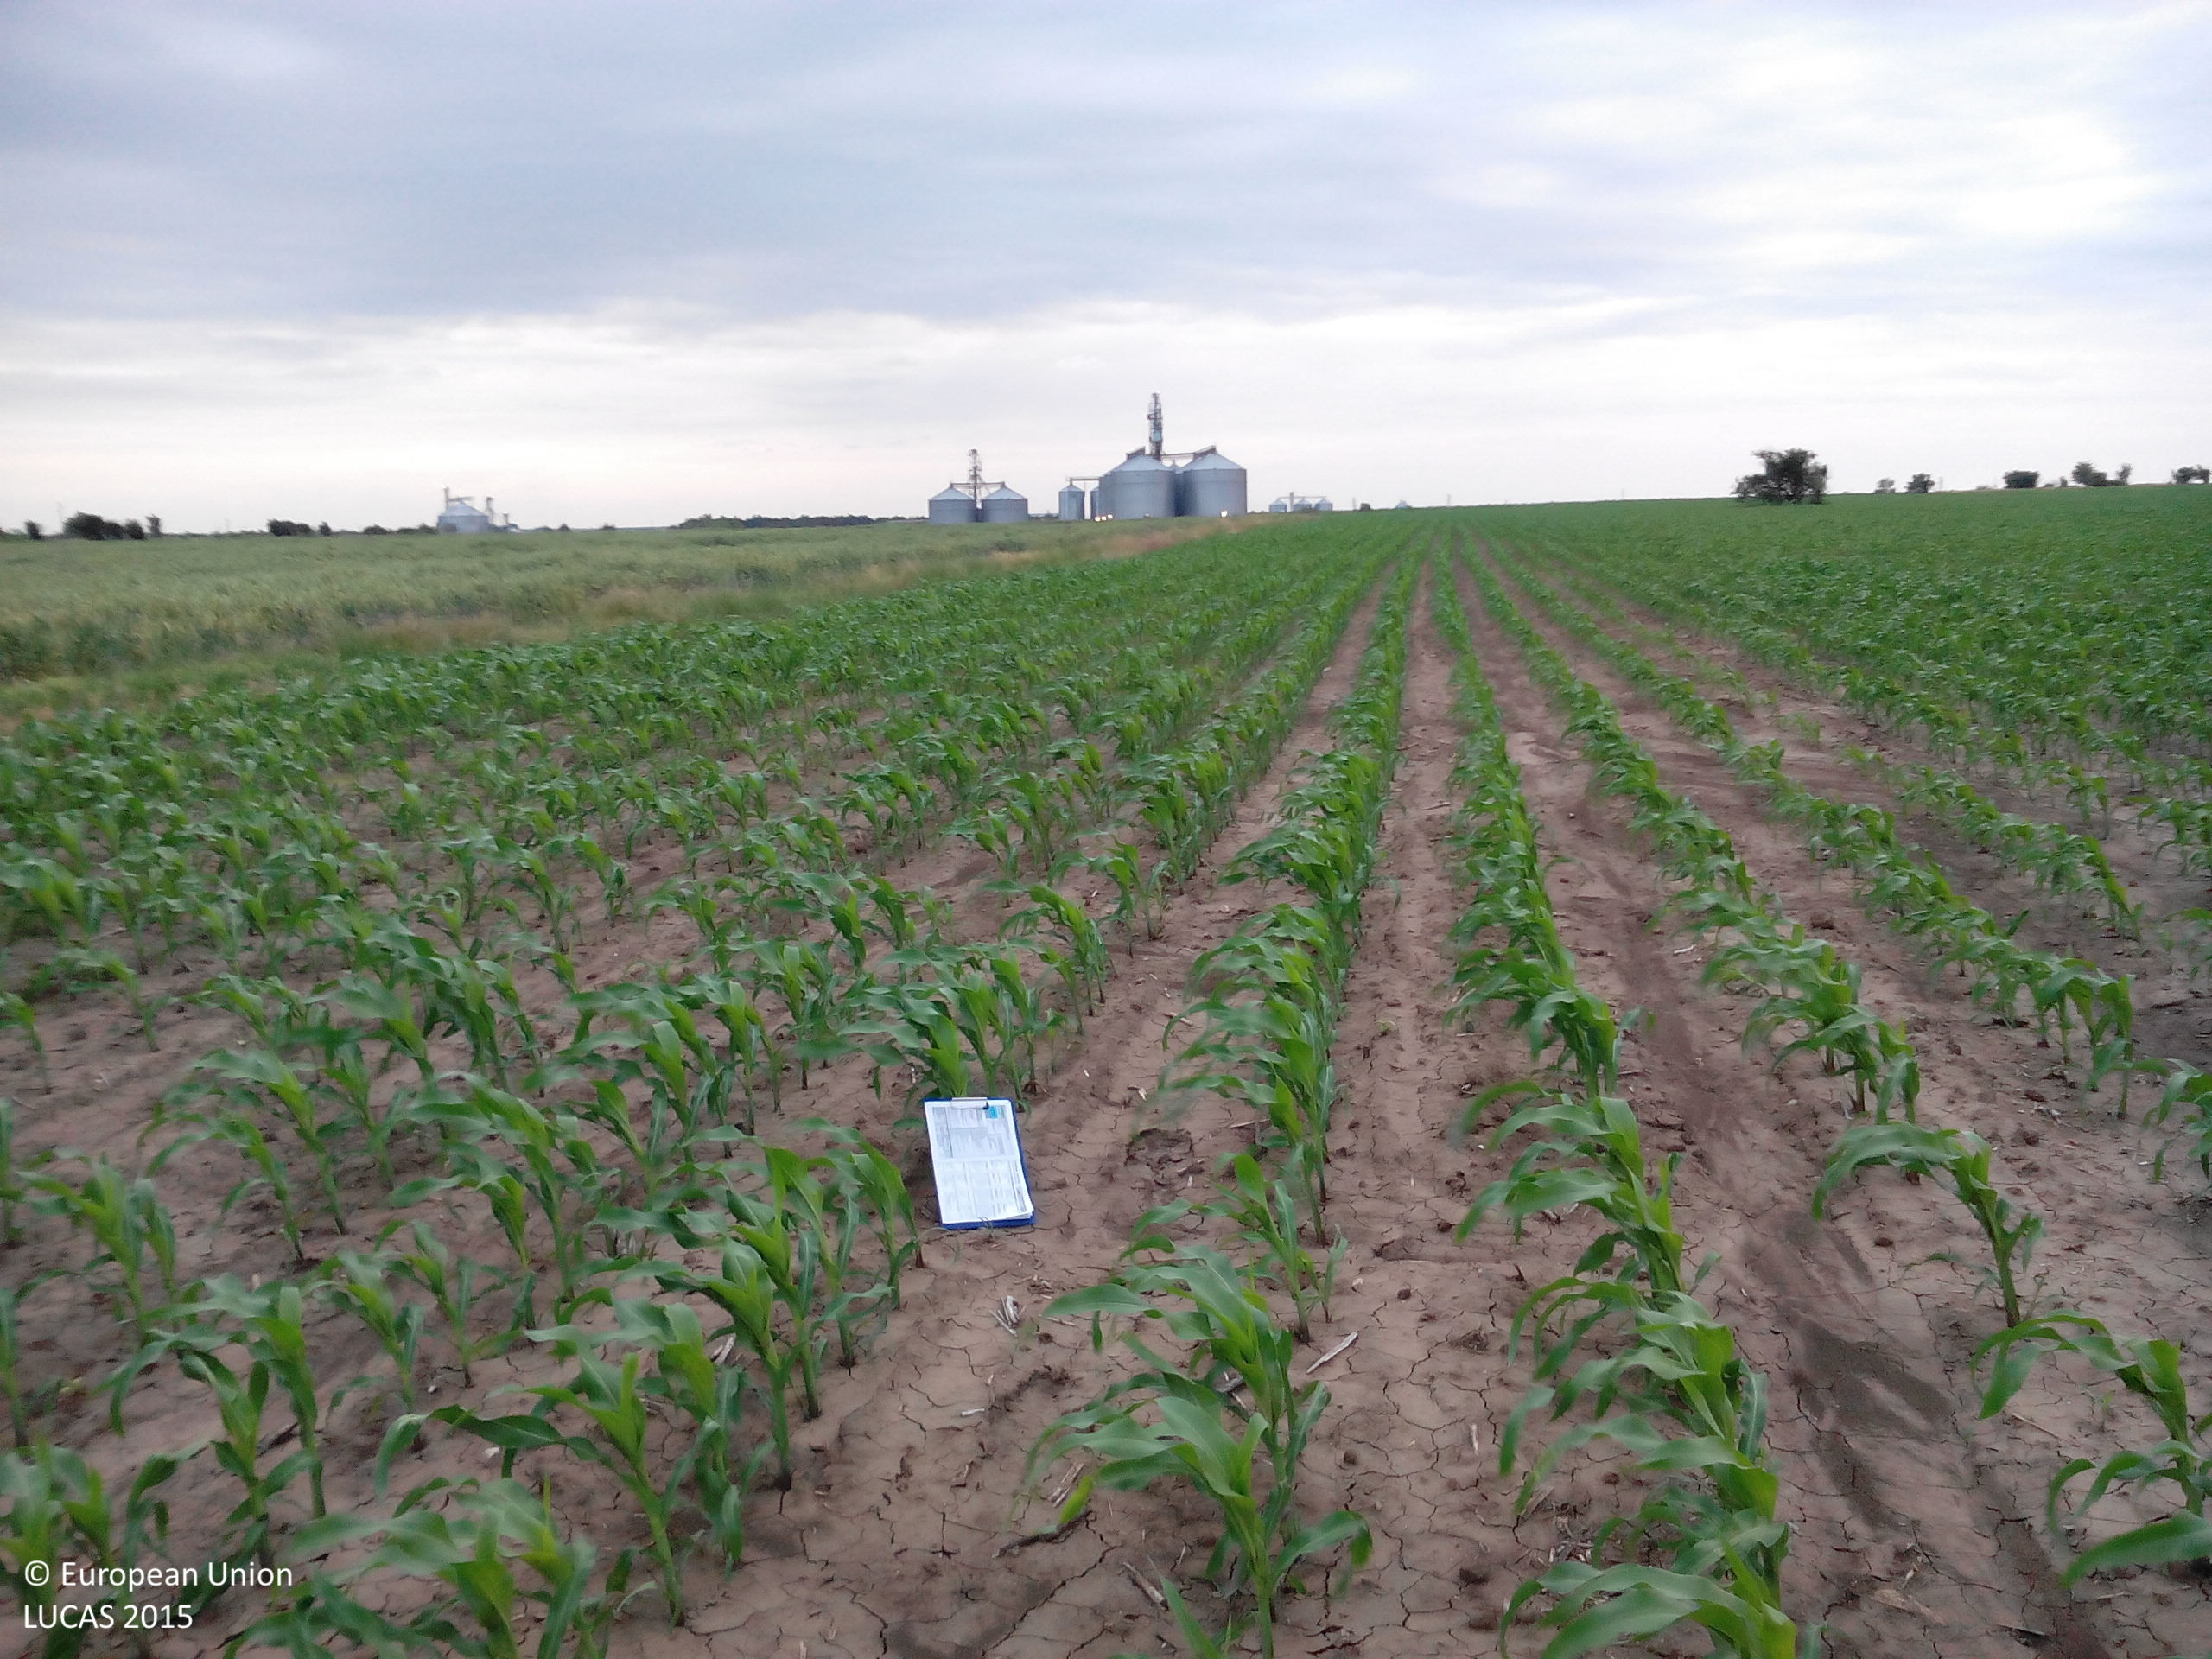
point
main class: Cropland
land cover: Maize
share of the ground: 25 - 50 %
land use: Agriculture (excluding fallow land and kitchen gardens)
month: May
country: BG
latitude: 43.5287
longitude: 24.0985
